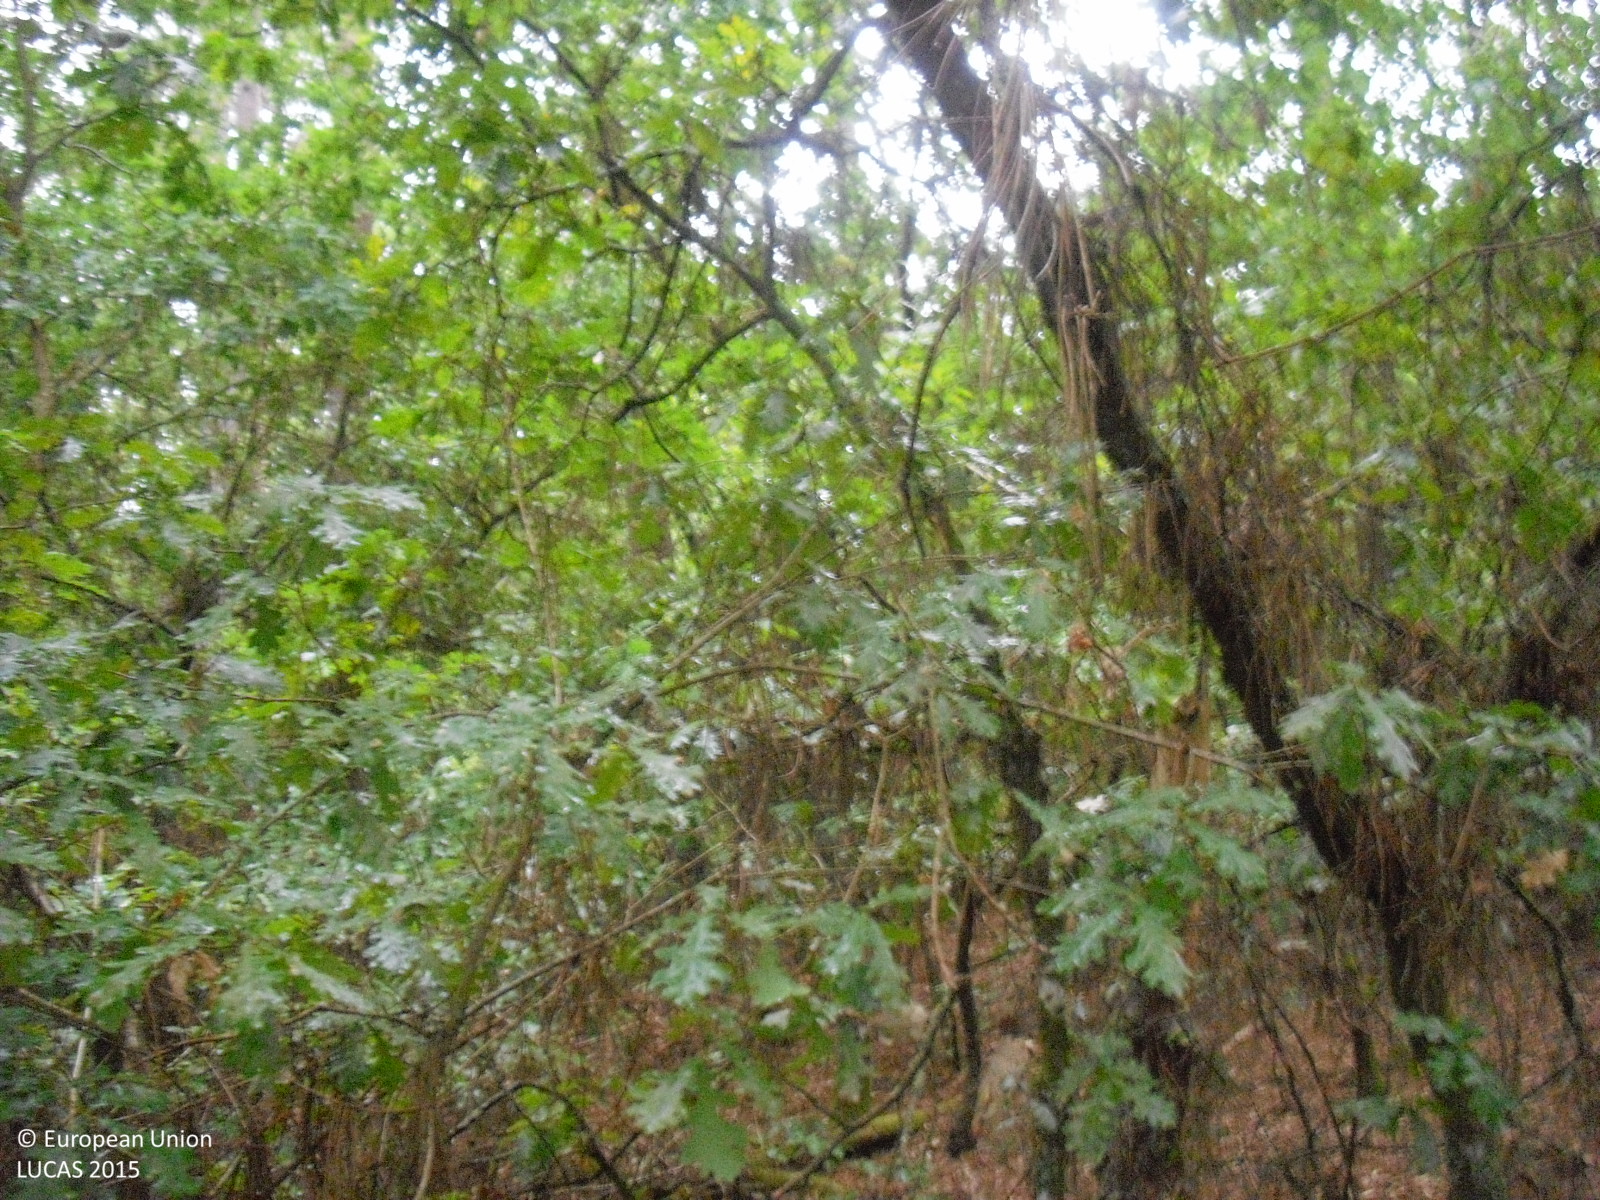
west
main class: Woodland
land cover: Pine dominated mixed woodland
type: hemiboreal forest and nemoral coniferous forest and mixed broadleaved-coniferous forest
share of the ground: > 75 %
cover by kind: coniferous forest trees 60 %, broadleaved forest trees 20 %, shrubs 20 %
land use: Forestry
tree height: > 5 m
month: July
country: ES
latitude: 42.3026
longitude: -7.6725
